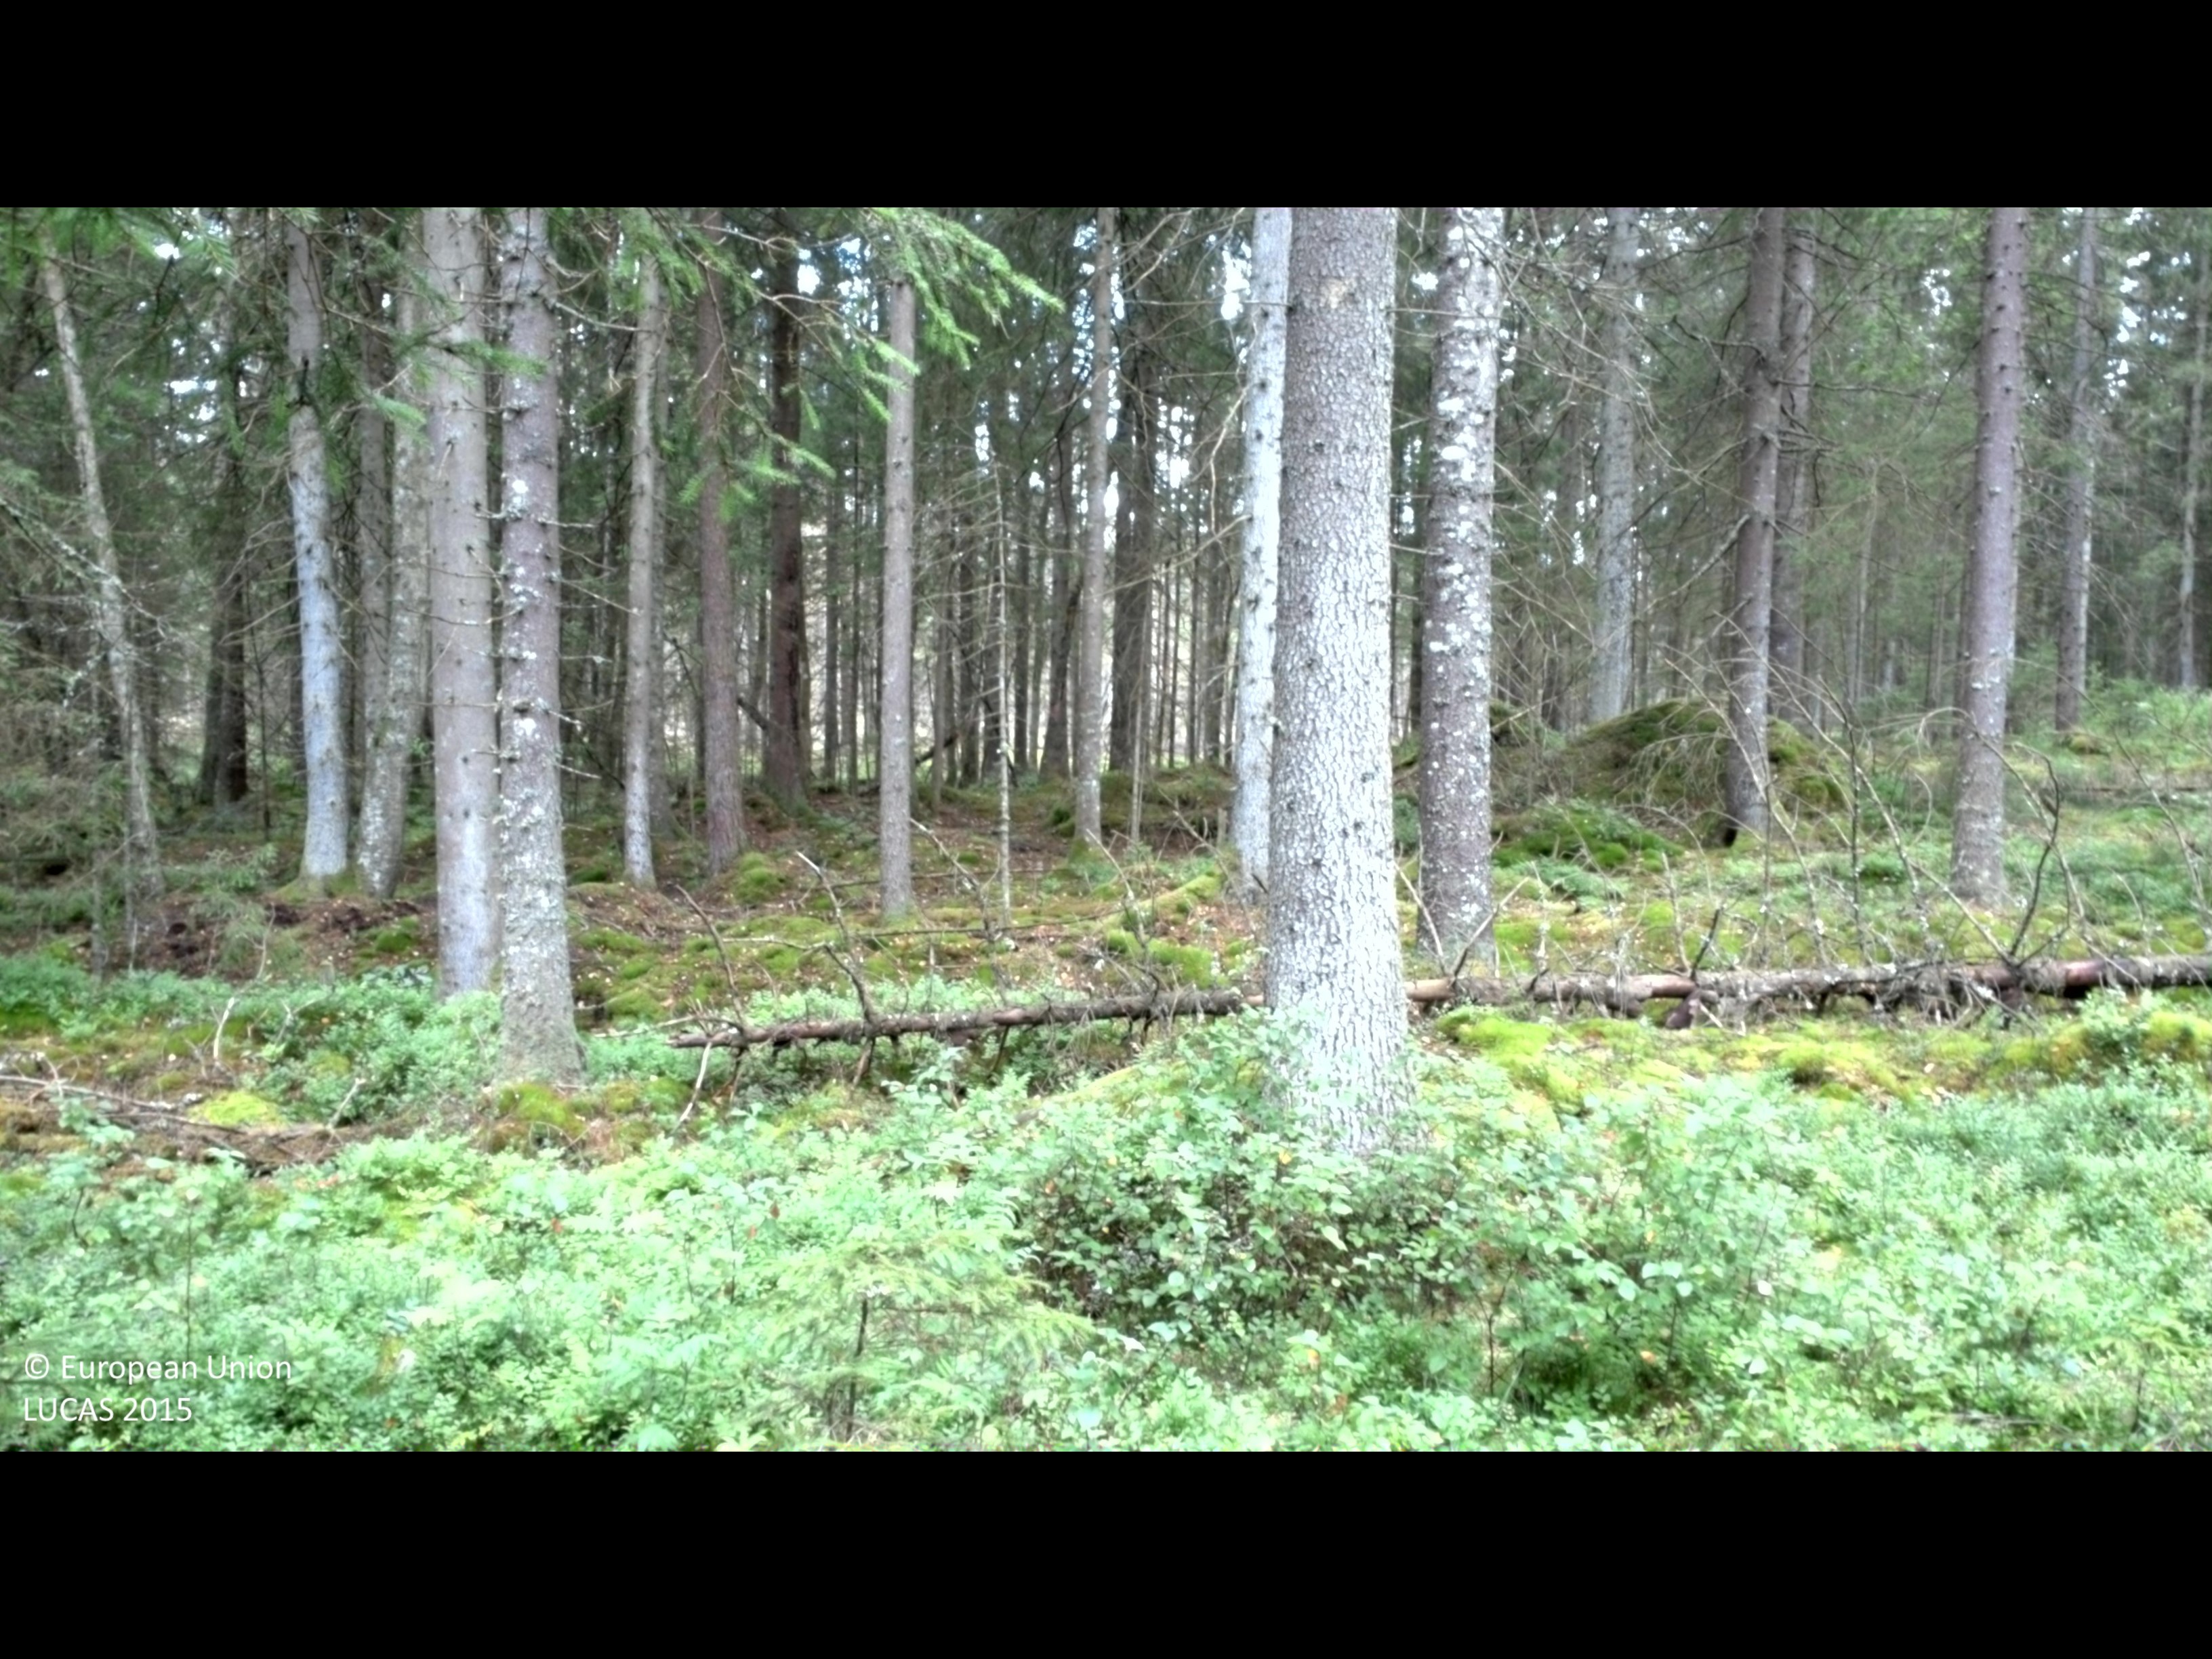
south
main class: Woodland
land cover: Spruce dominated coniferous woodland
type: boreal forest
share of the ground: 50 - 75 %
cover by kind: coniferous forest trees 60 %, shrubs 30 %, broadleaved forest trees 5 %, lichens and mosses 5 %
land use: Forestry
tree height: > 5 m
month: August
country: SE
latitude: 57.0465
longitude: 13.2435
